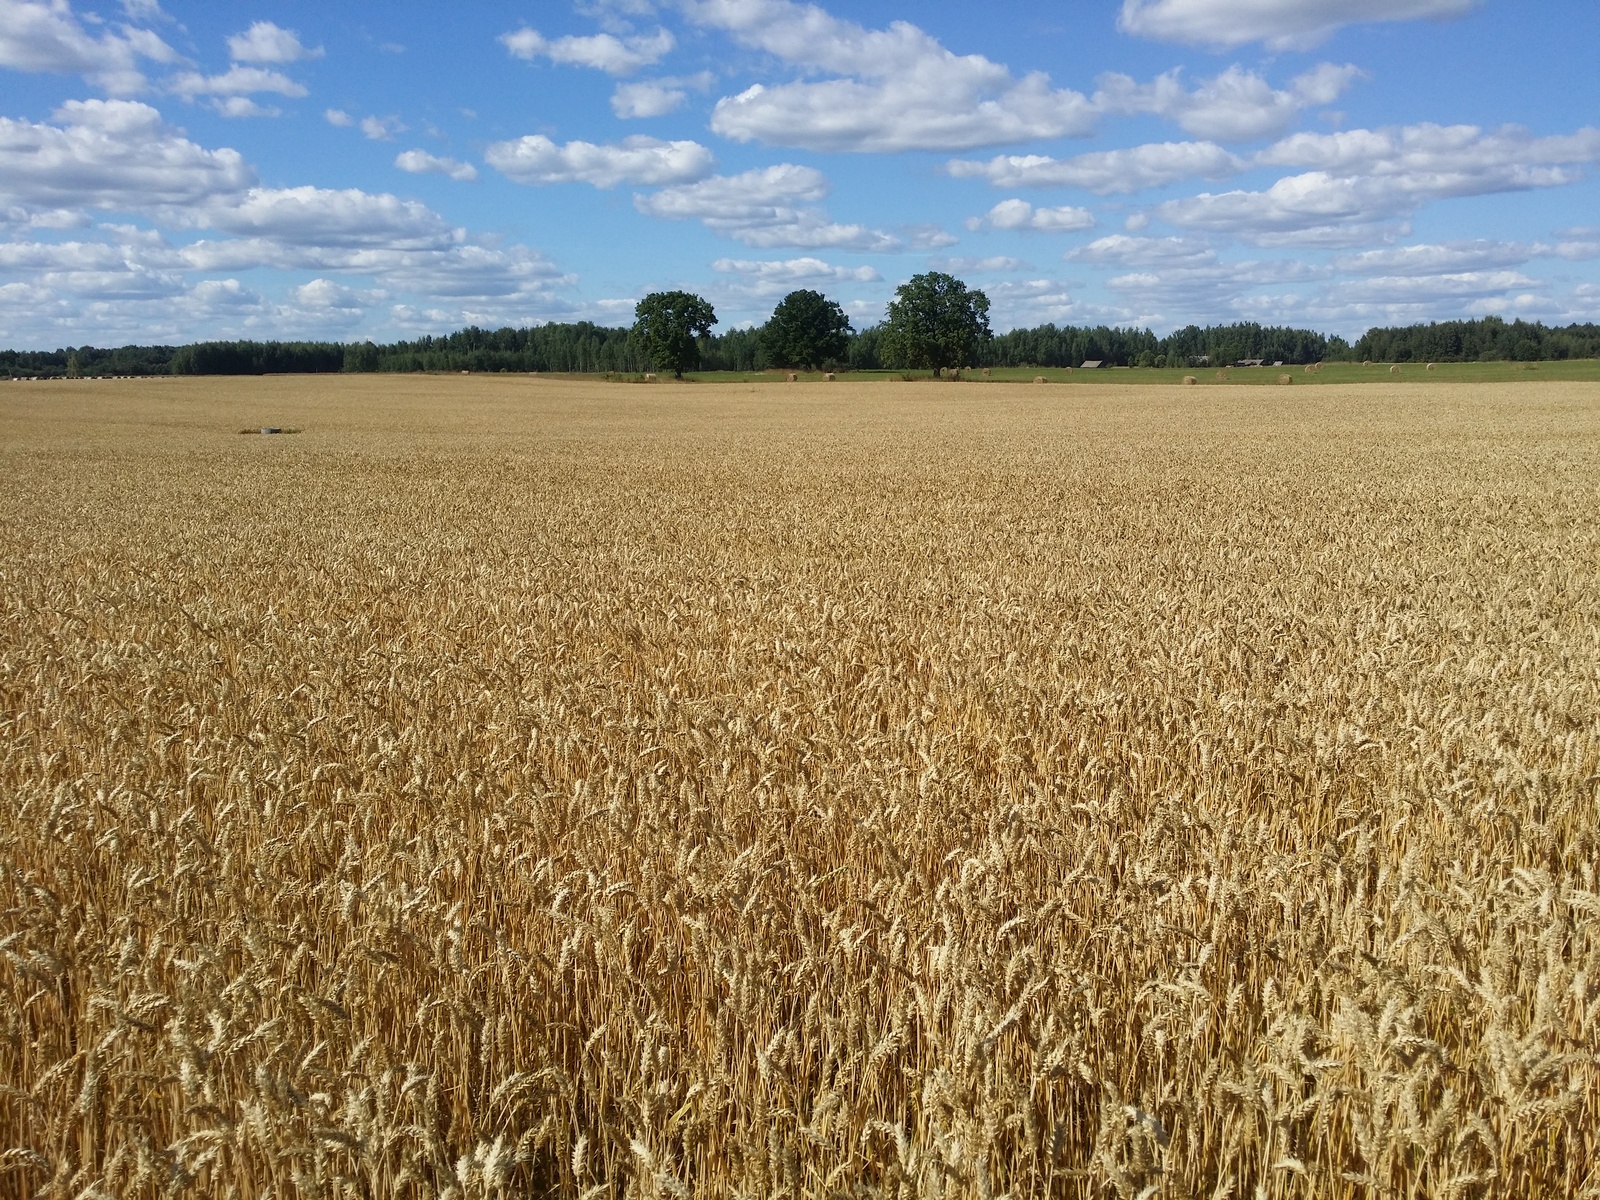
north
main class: Cropland
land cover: Common wheat
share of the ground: > 75 %
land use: Agriculture (excluding fallow land and kitchen gardens)
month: August
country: LV
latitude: 56.9951
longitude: 27.6804
